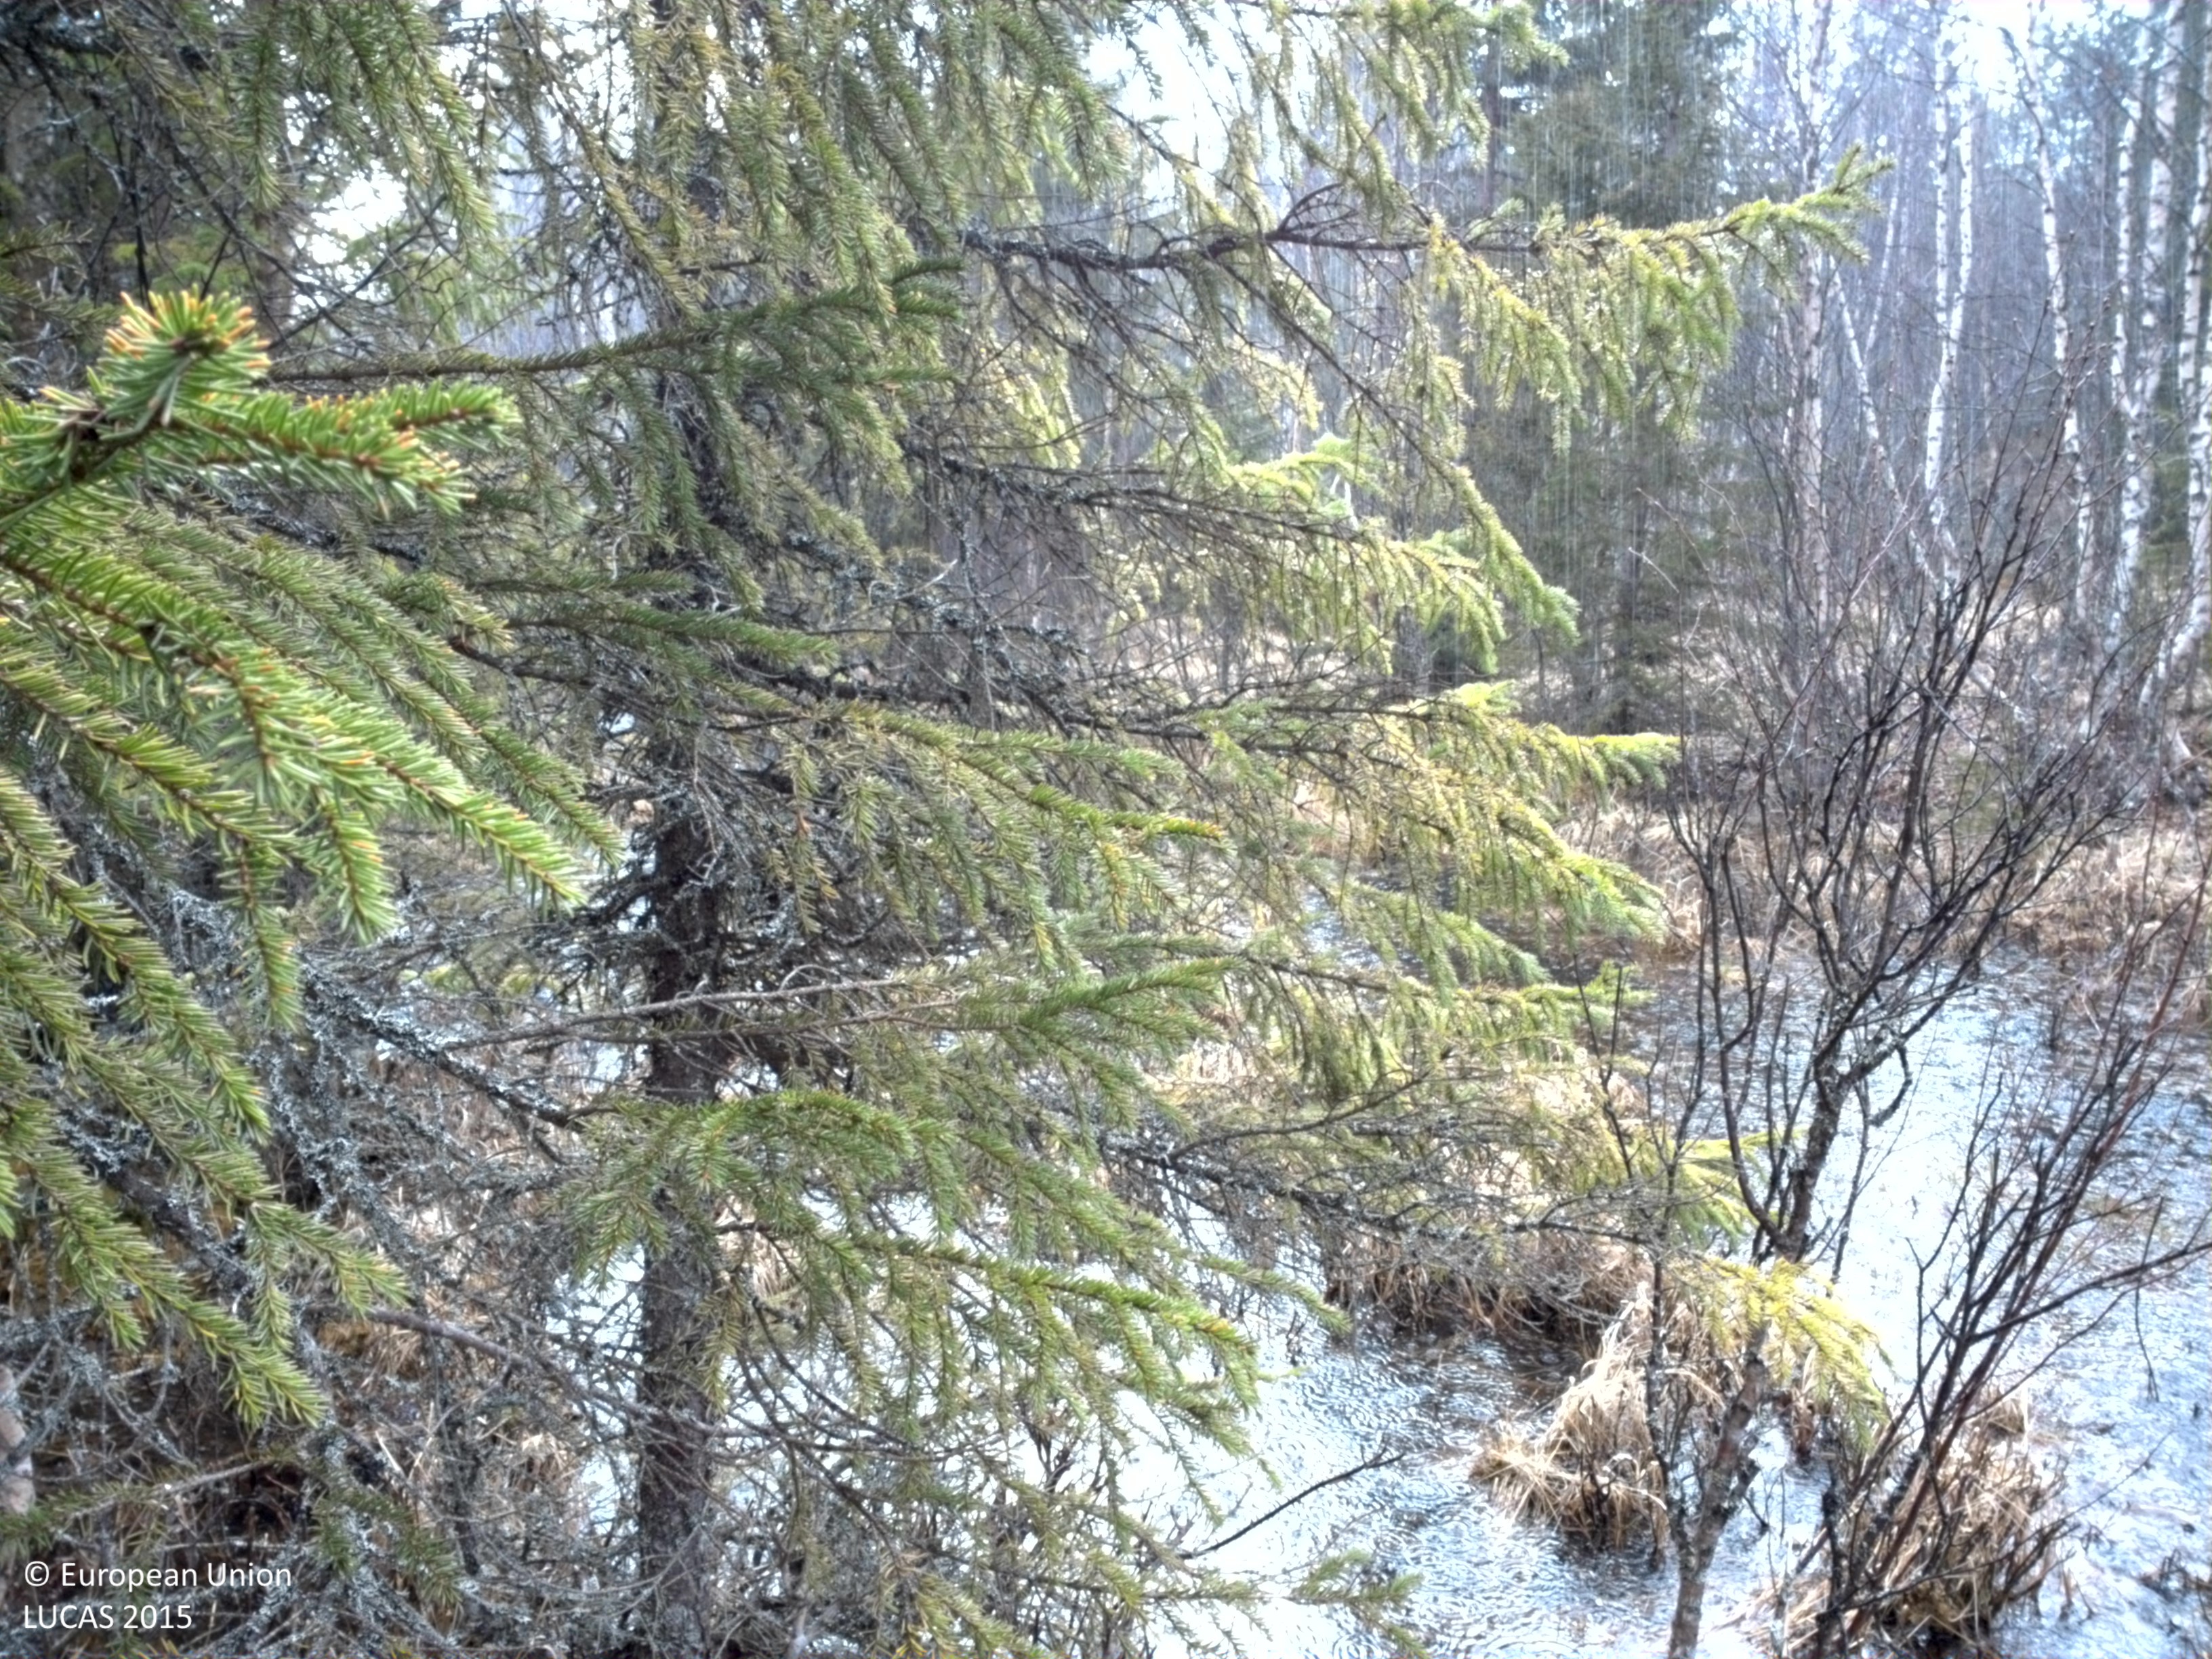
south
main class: Woodland
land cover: Spruce dominated mixed woodland
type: boreal forest
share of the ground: > 75 %
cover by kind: coniferous forest trees 75 %, broadleaved forest trees 25 %
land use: Forestry
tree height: > 5 m
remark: Temporary flooded
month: May
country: SE
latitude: 63.3558
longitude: 13.9179
